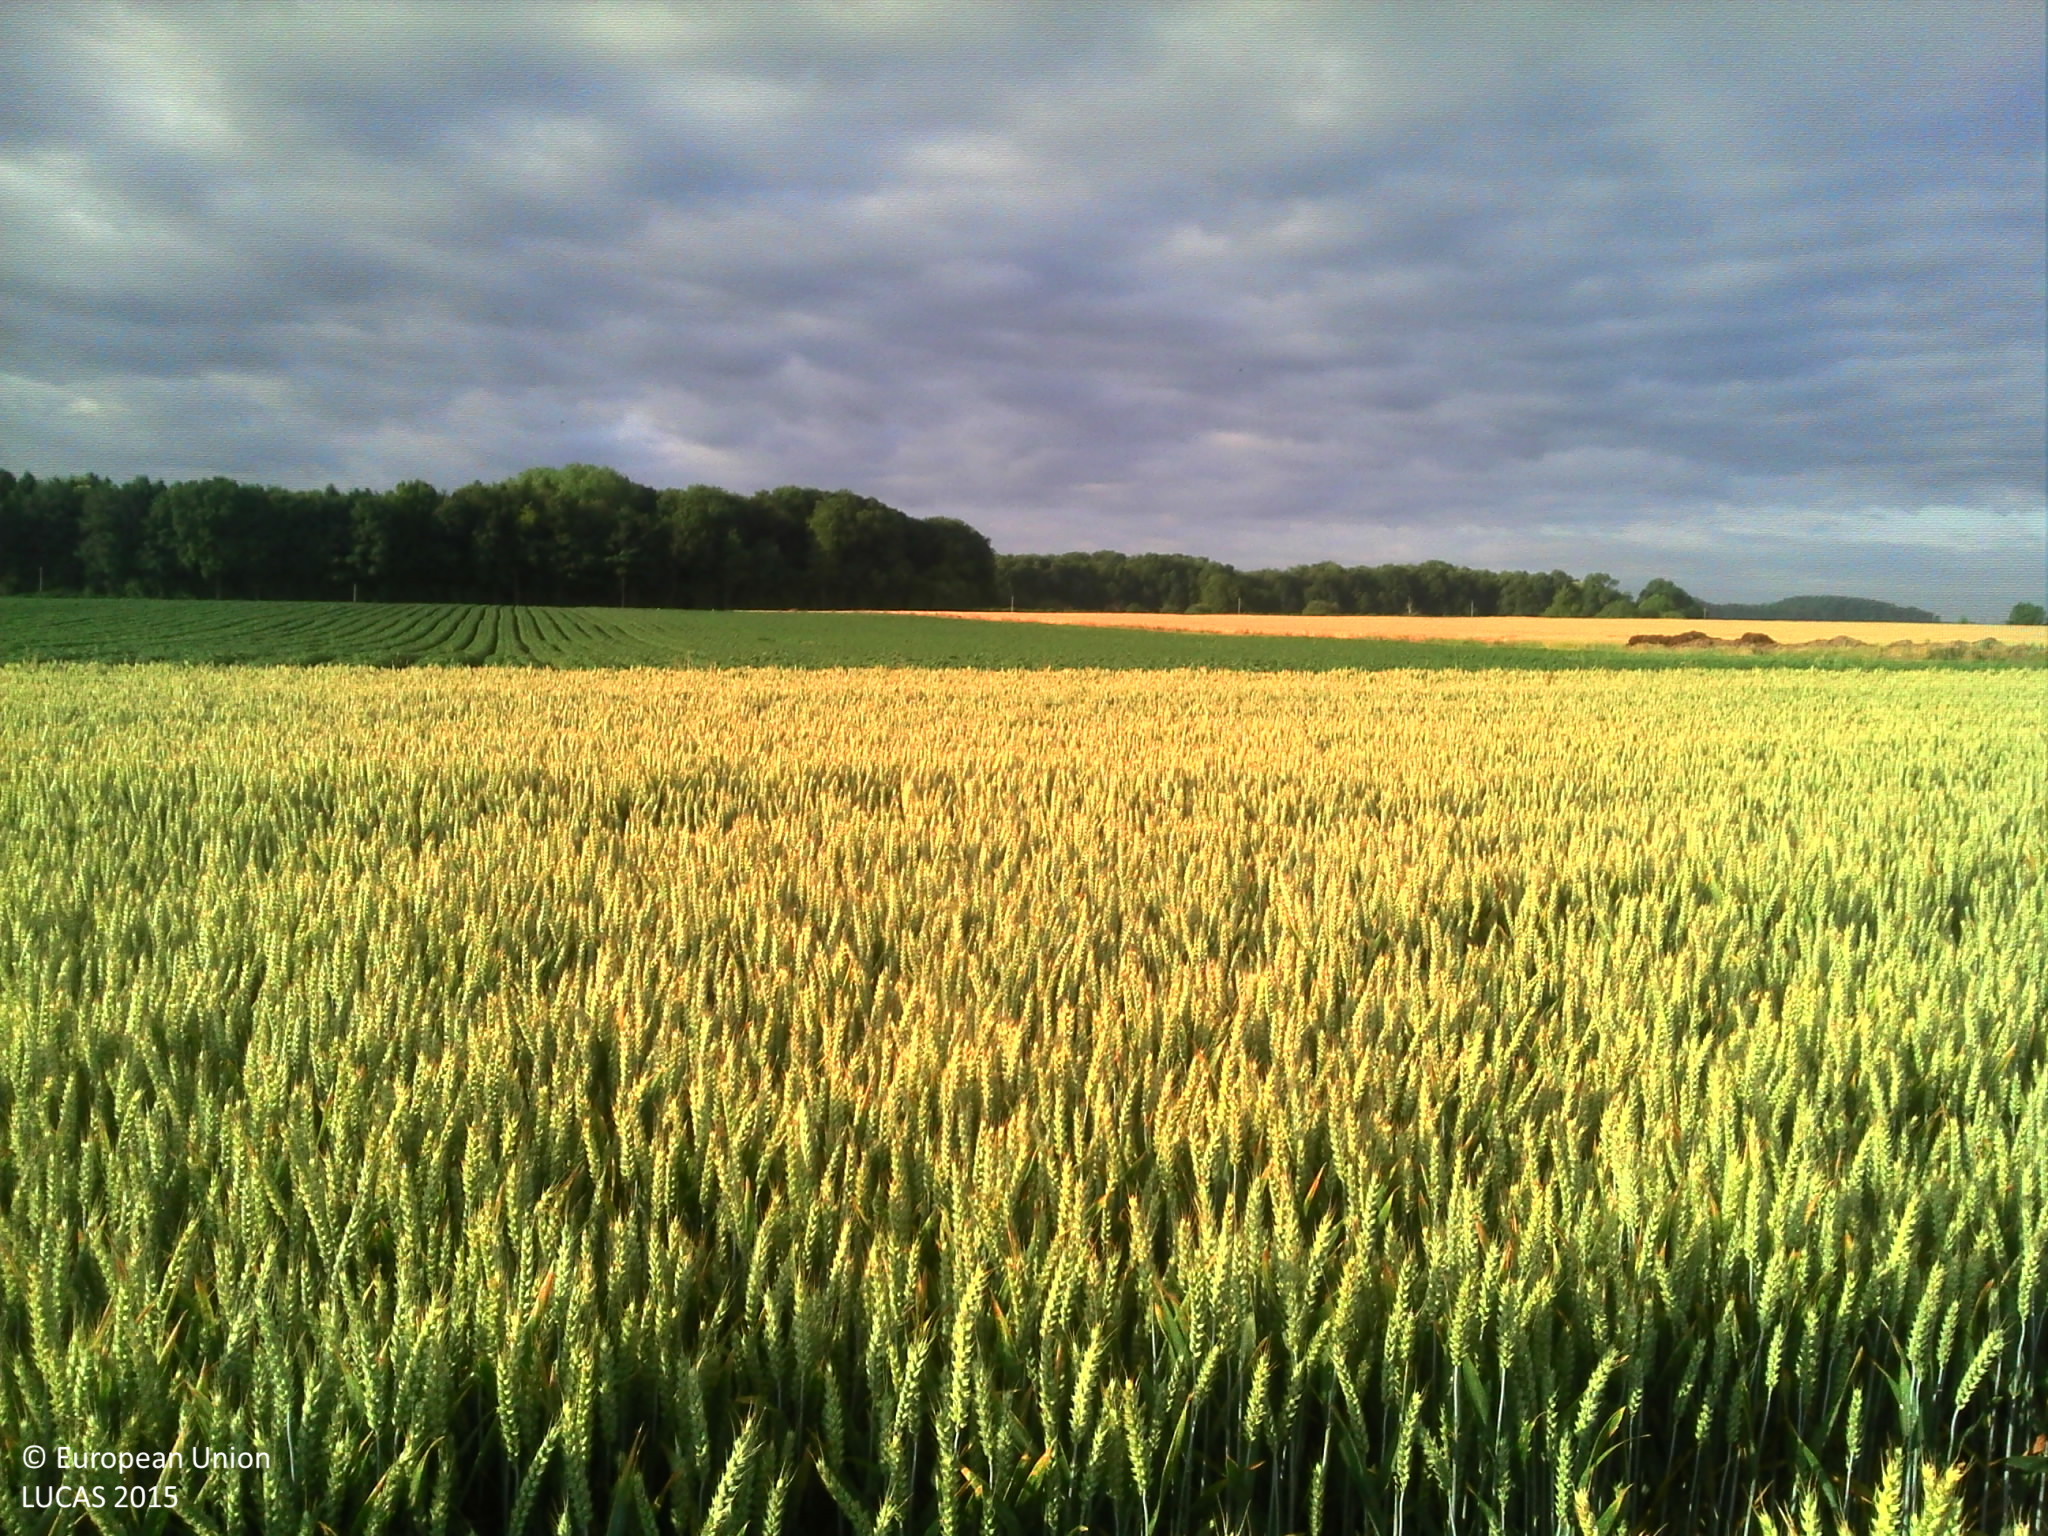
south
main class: Cropland
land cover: Common wheat
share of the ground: > 75 %
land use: Agriculture (excluding fallow land and kitchen gardens)
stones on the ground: < 10 %
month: July
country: FR
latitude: 49.7665
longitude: 1.8618
